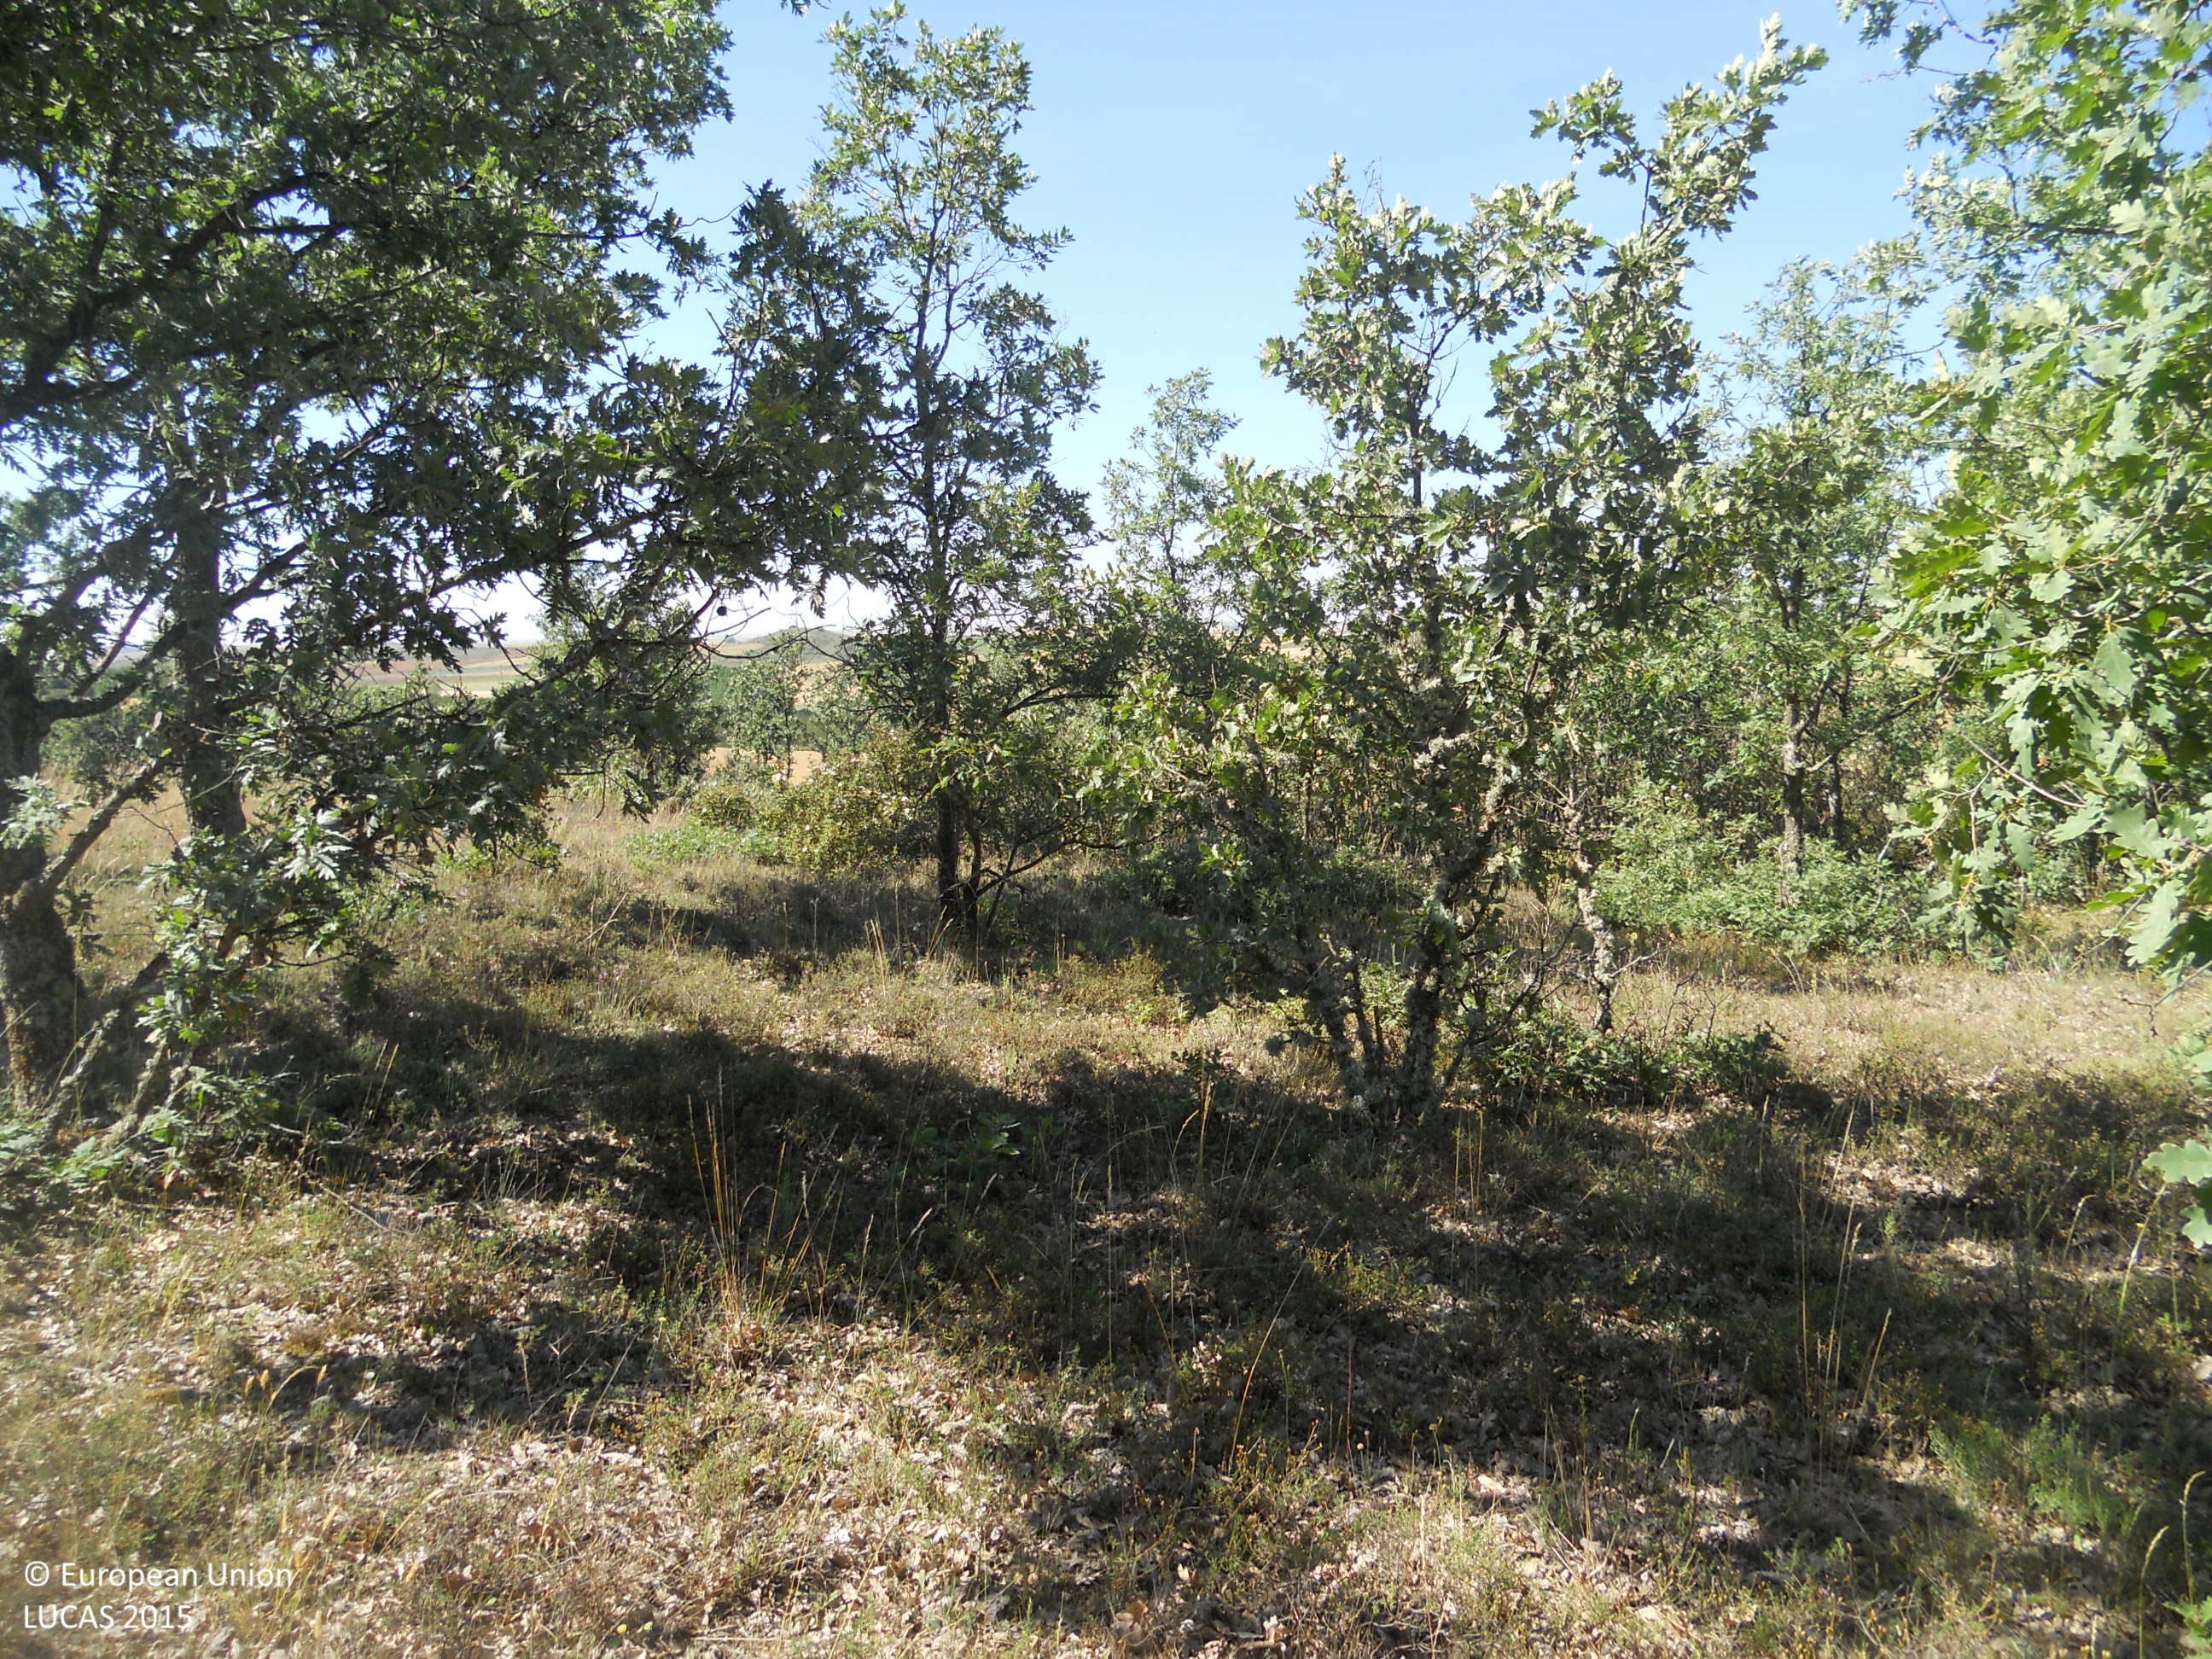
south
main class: Woodland
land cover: Broadleaved woodland
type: thermophilous deciduous forest
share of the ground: 50 - 75 %
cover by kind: herbaceous plants 55 %, broadleaved forest trees 45 %
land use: Forestry
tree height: > 5 m
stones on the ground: > 50 %
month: June
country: ES
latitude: 42.3898
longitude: -4.8886
